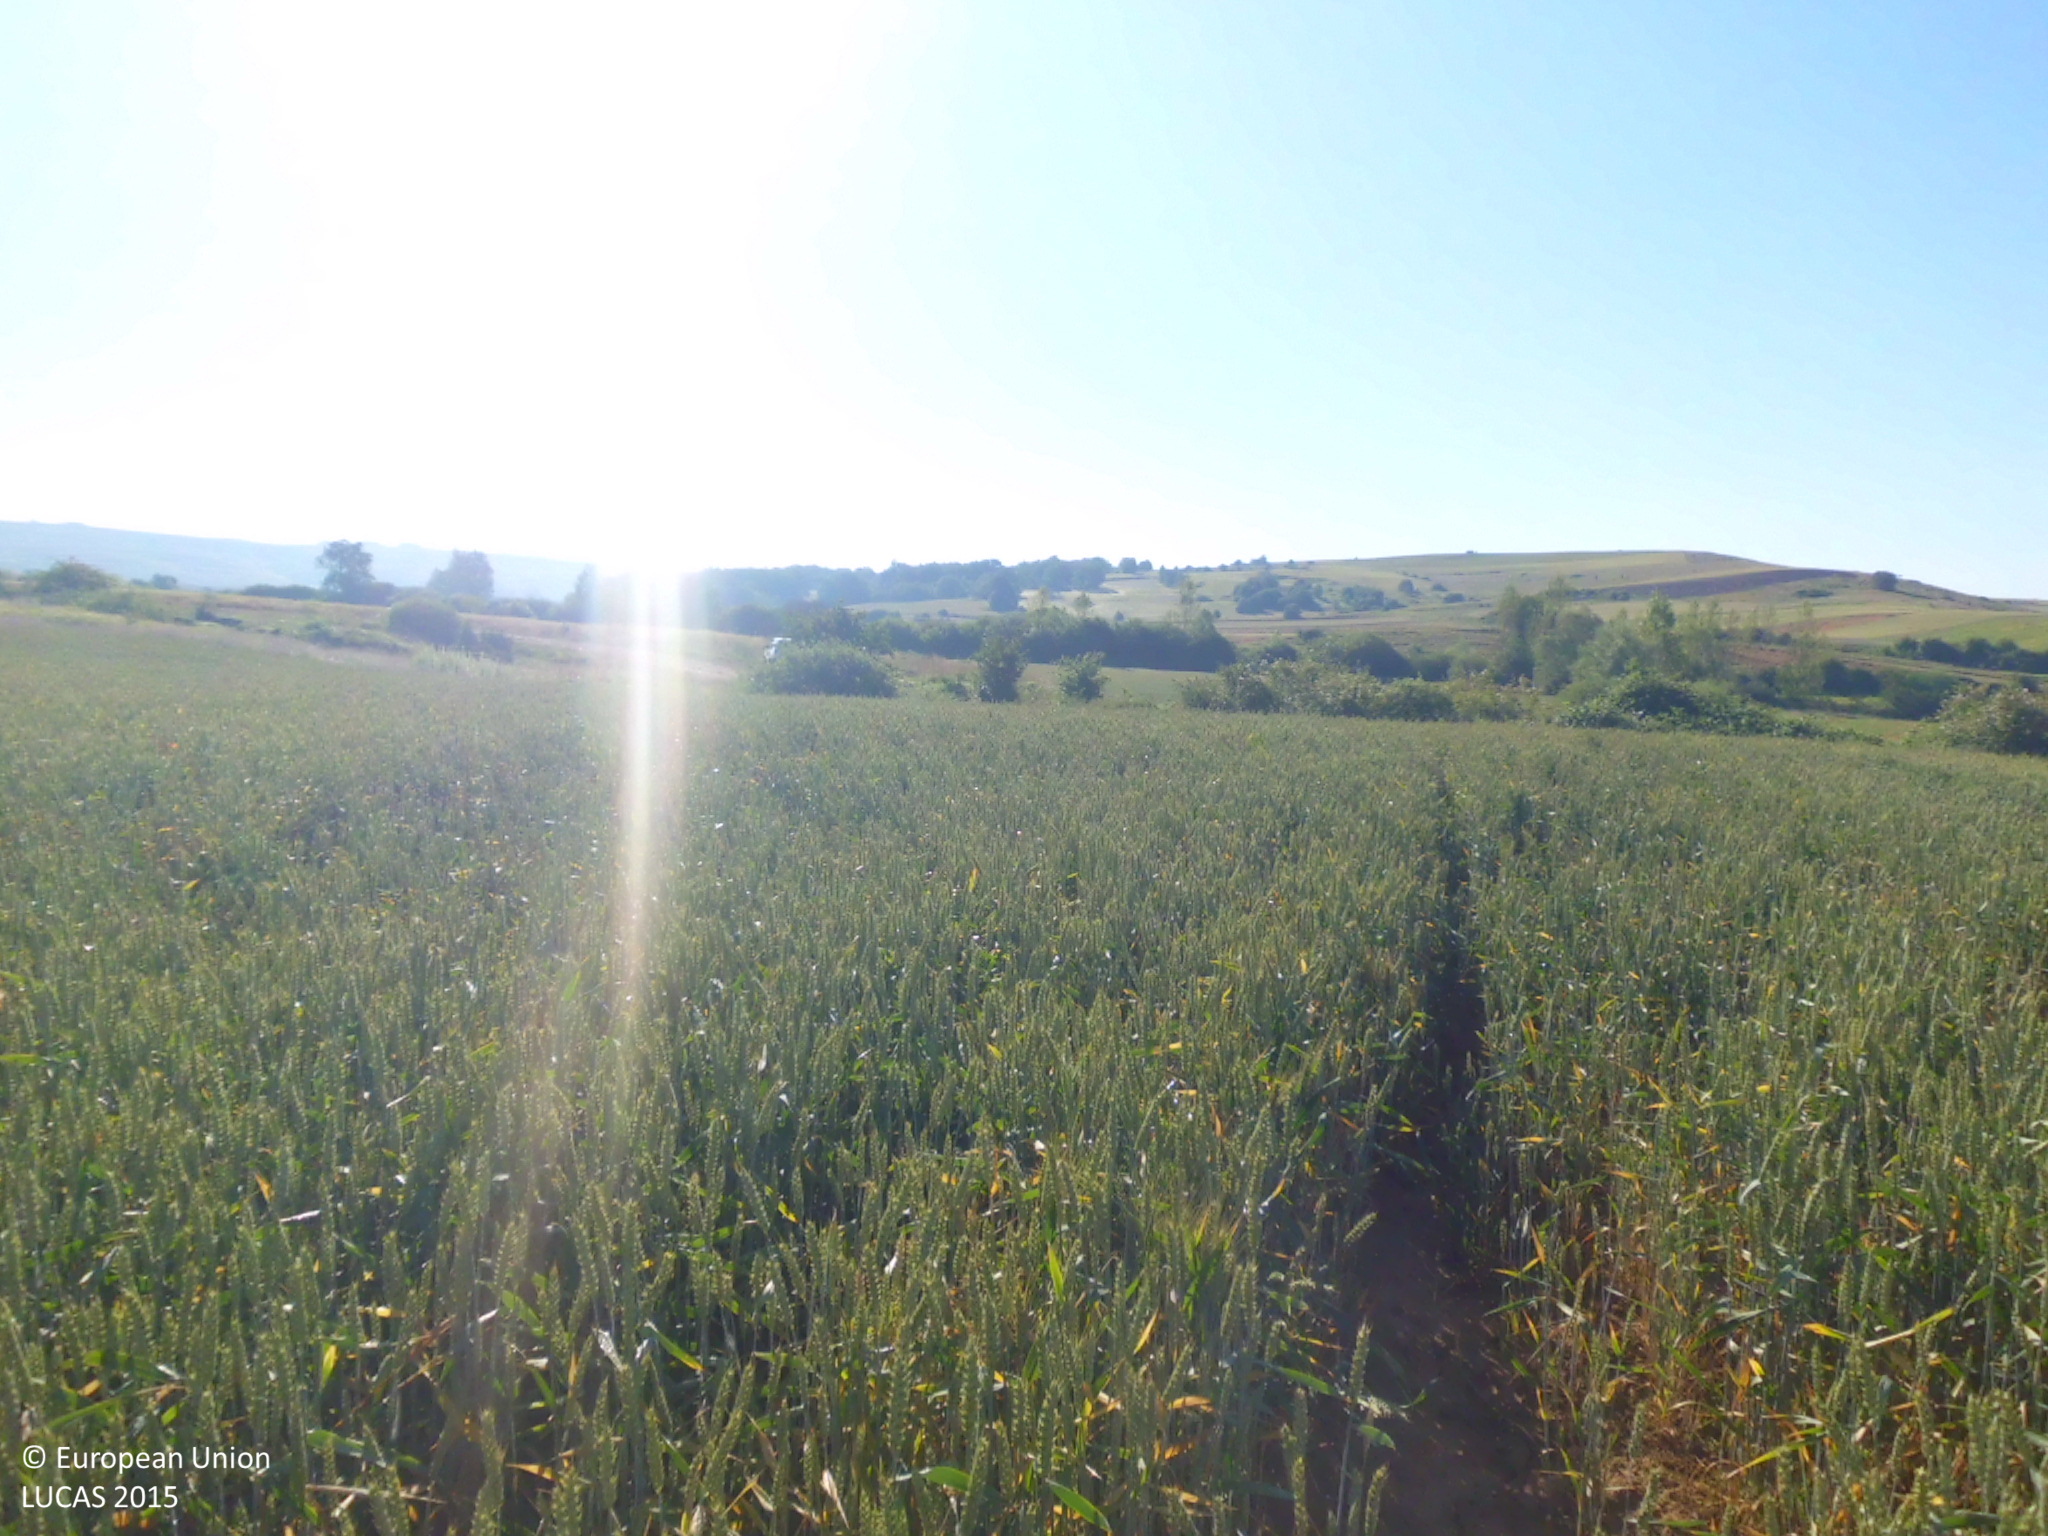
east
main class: Cropland
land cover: Common wheat
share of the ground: > 75 %
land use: Agriculture (excluding fallow land and kitchen gardens)
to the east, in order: Common wheat; Grassland with sparse tree/shrub cover; Tracks; Common wheat; Grass margins; Common wheat; Rivers and streams; Common wheat
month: June
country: ES
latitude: 42.6548
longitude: -3.9375
